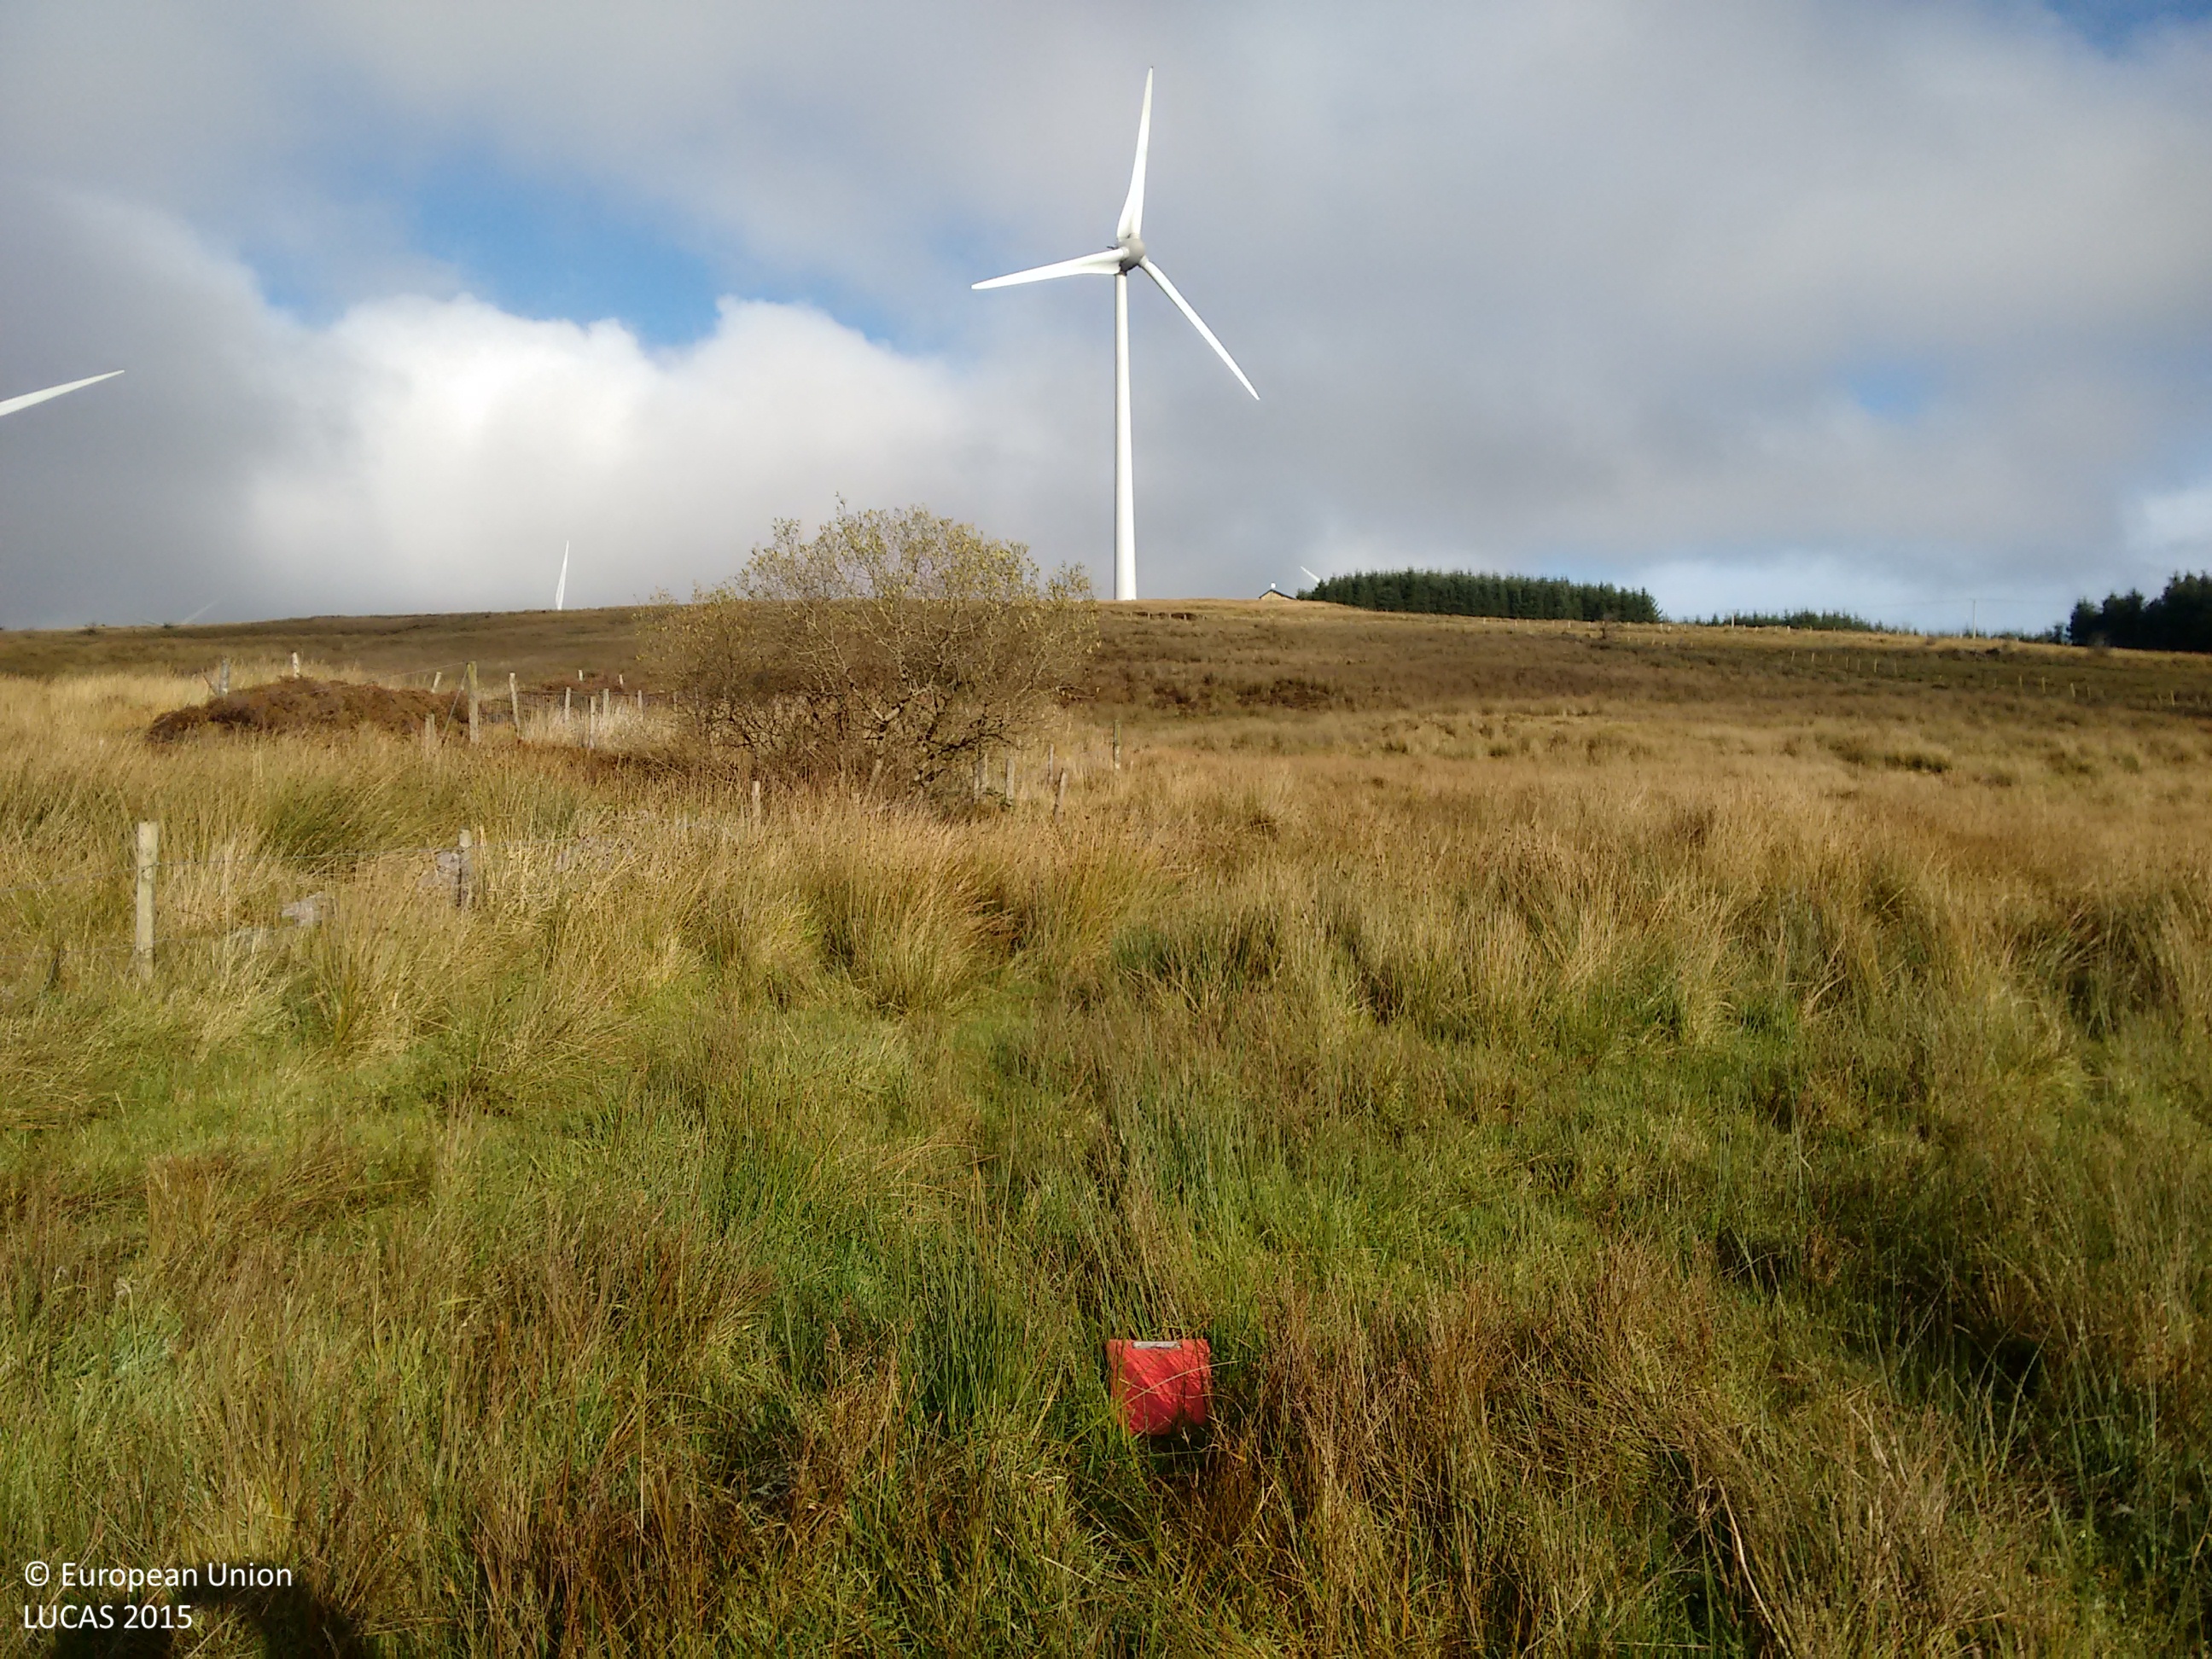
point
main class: Grassland
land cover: Grassland without tree/shrub cover
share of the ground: > 75 %
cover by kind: herbaceous plants 100 %
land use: Agriculture (excluding fallow land and kitchen gardens)
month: October
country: IE
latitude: 54.1045
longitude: -8.1180
